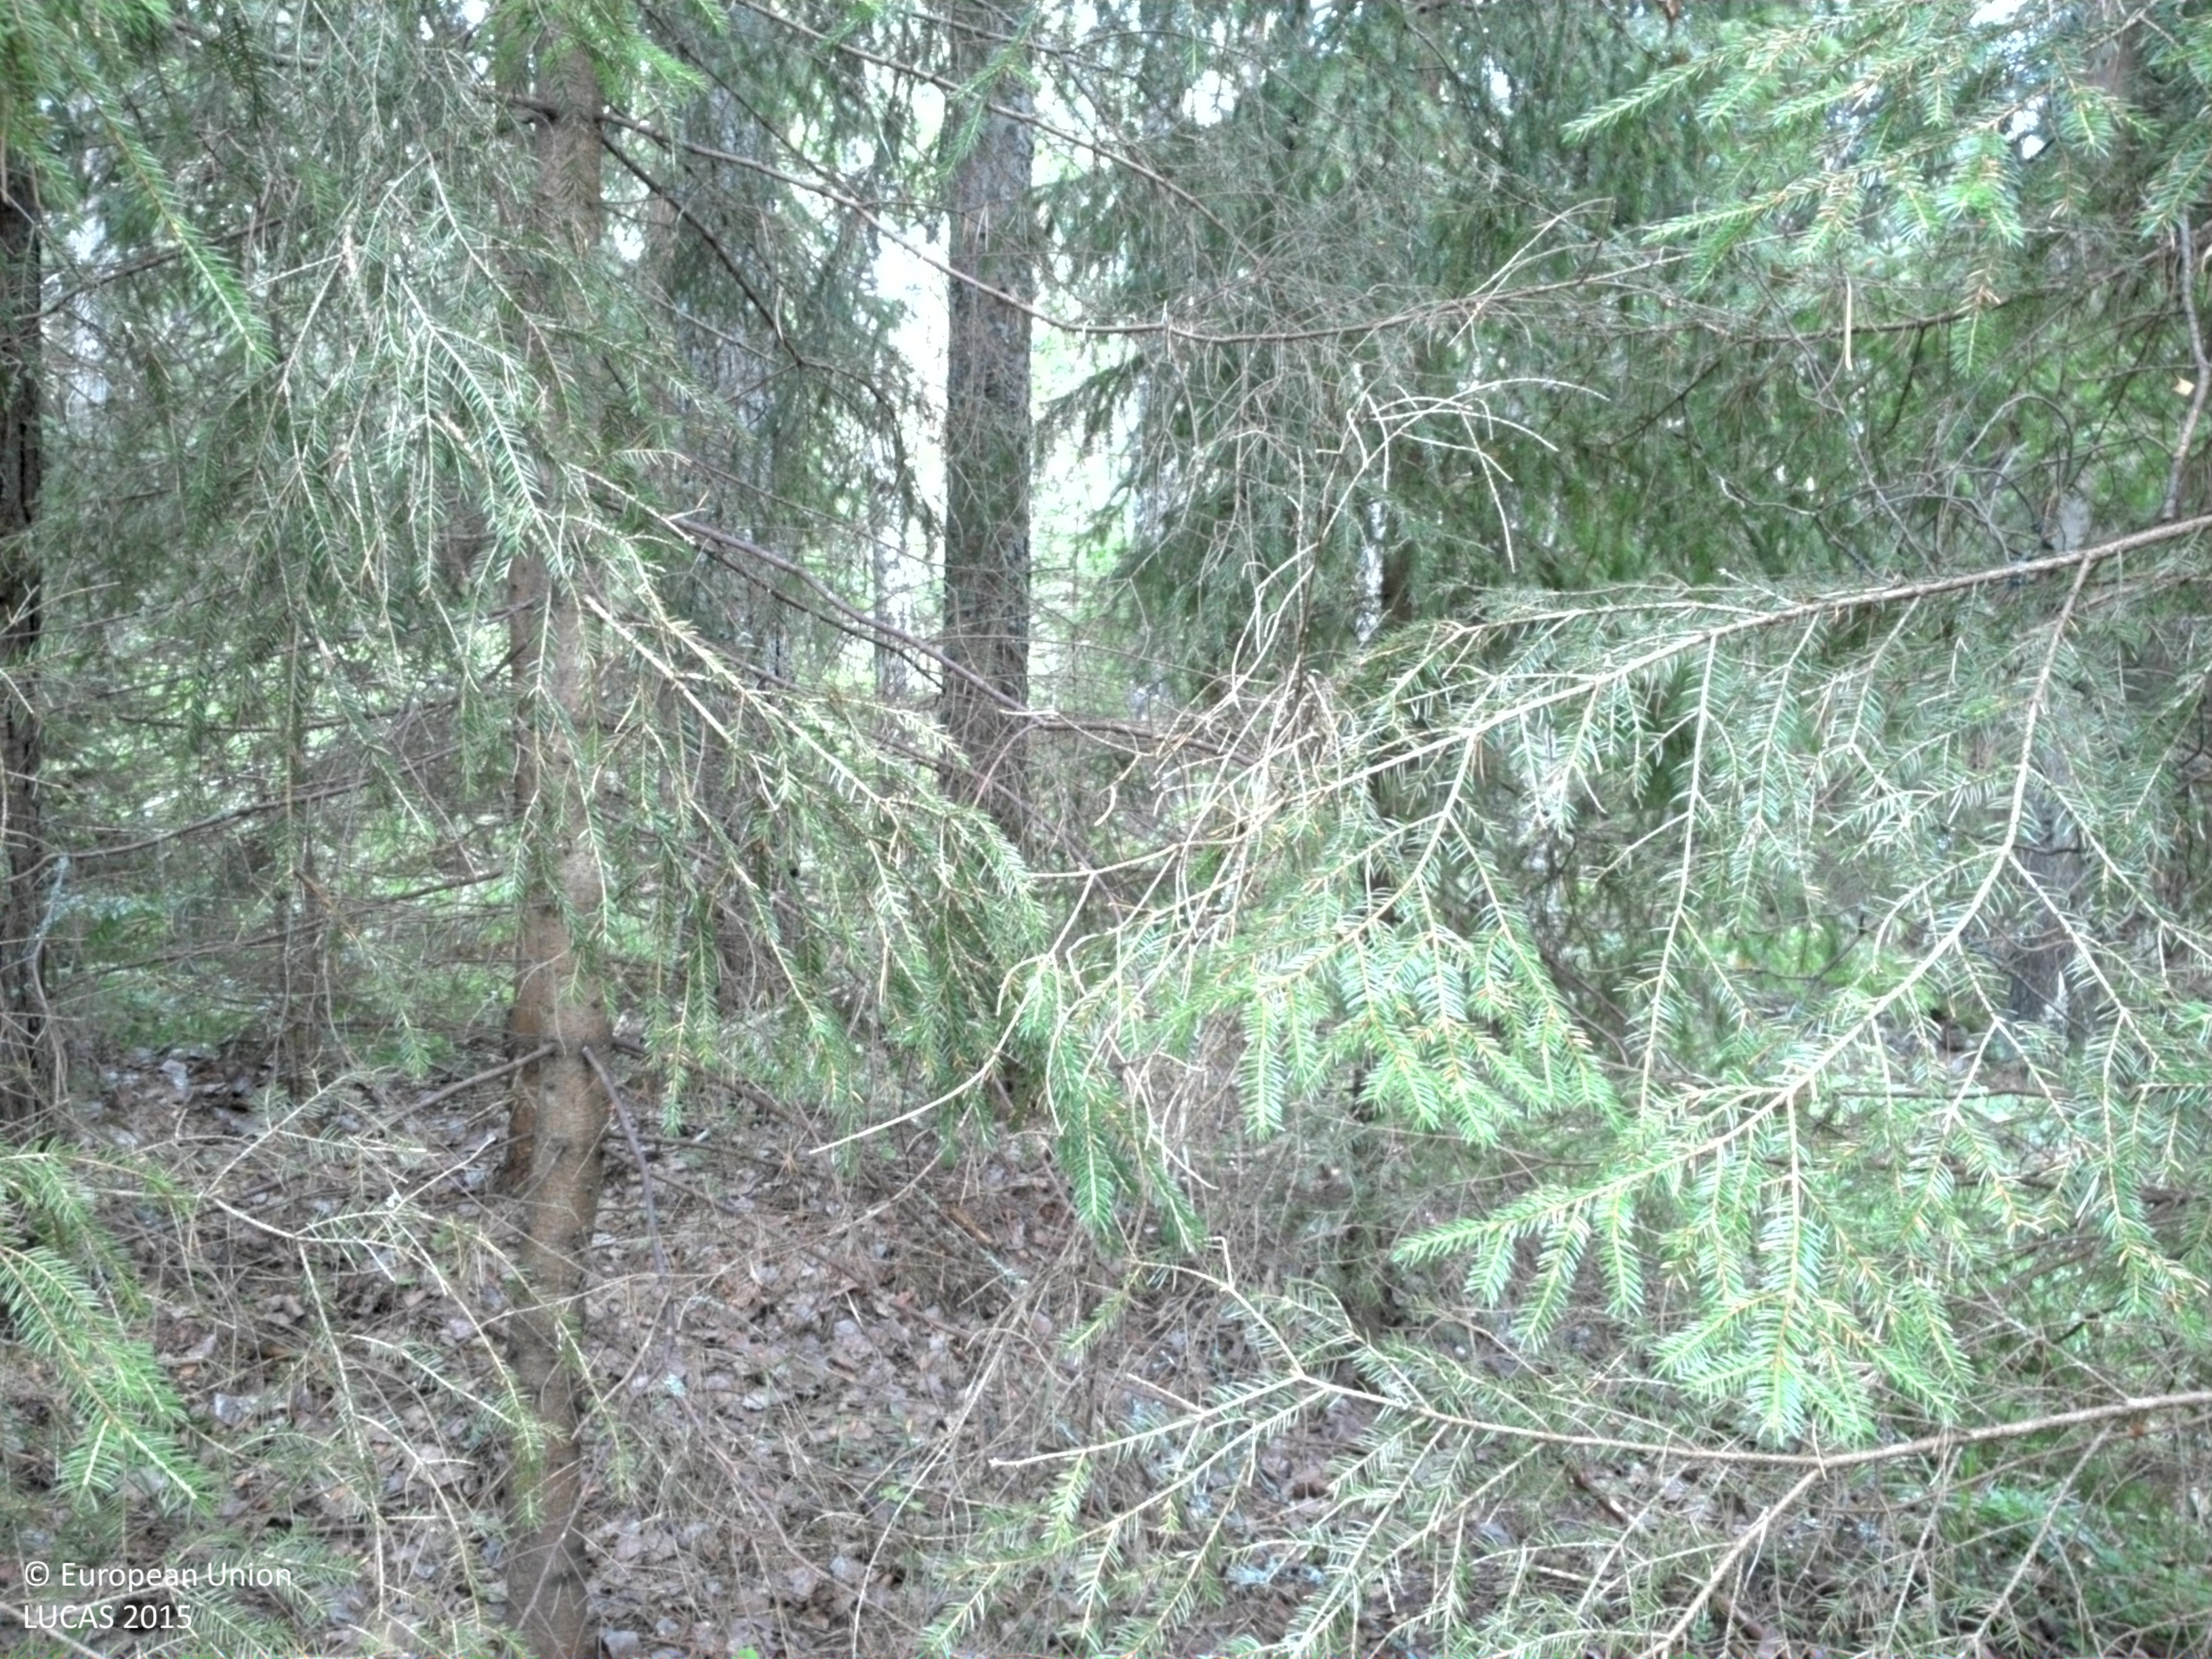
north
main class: Woodland
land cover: Spruce dominated coniferous woodland
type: boreal forest
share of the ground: > 75 %
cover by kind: coniferous forest trees 75 %, shrubs 10 %, lichens and mosses 10 %, broadleaved forest trees 5 %
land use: Forestry
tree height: > 5 m
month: July
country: SE
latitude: 59.4852
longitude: 18.5640
